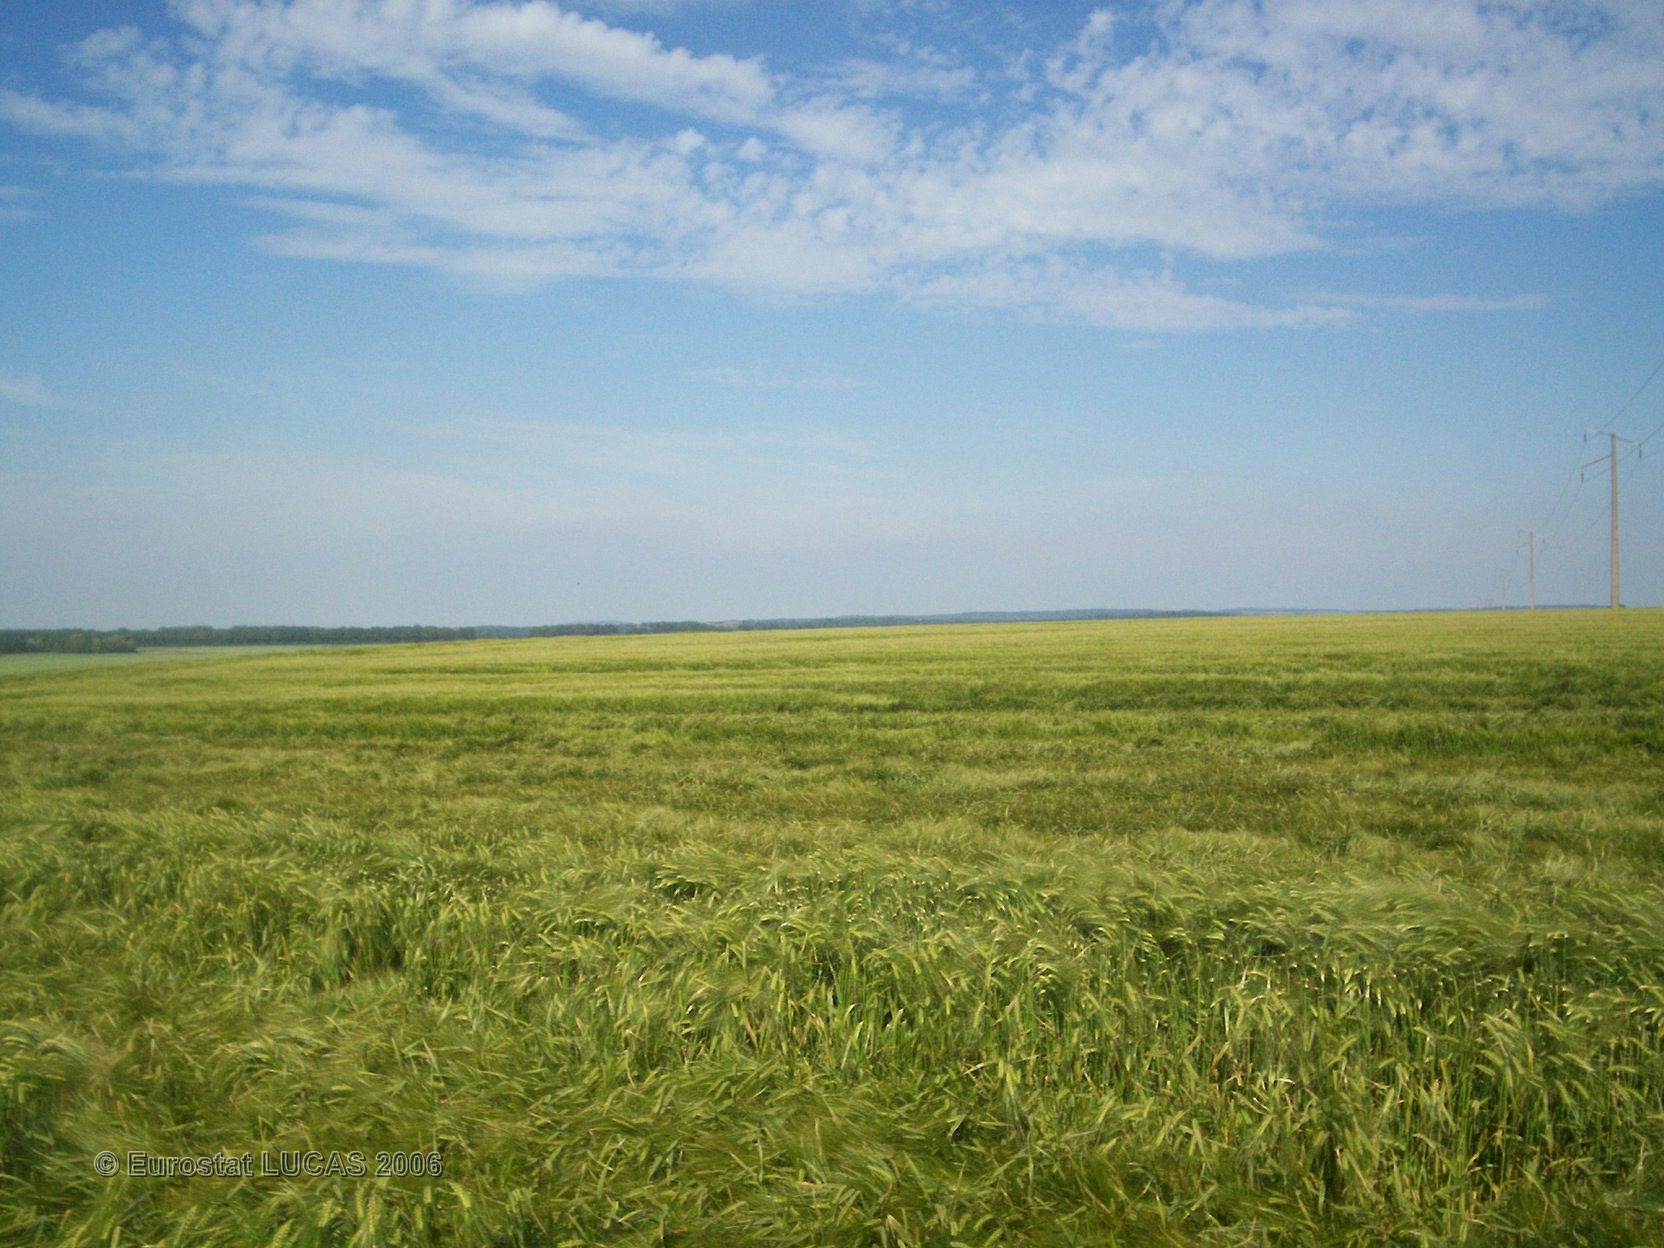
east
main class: Cropland
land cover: Barley
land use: Agriculture (excluding fallow land and kitchen gardens)
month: June
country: FR
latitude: 49.5495
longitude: 2.6493
